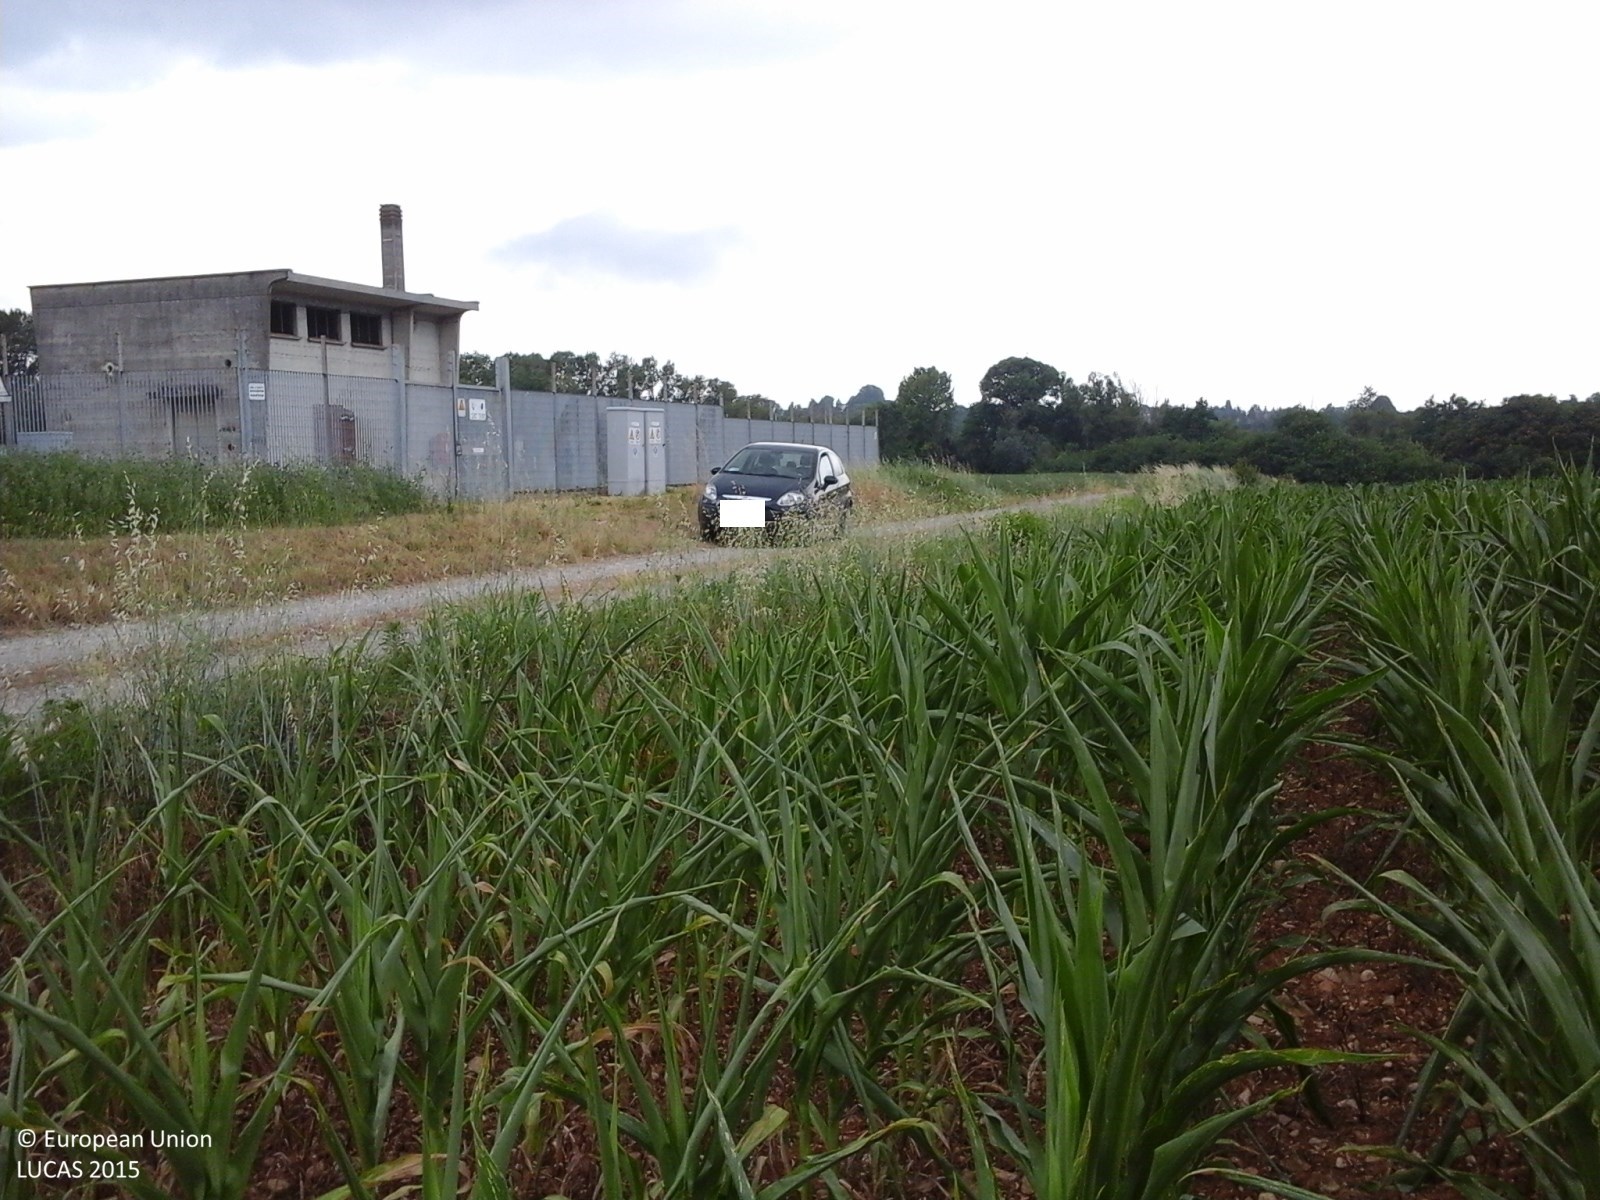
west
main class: Cropland
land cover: Maize
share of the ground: > 75 %
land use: Agriculture (excluding fallow land and kitchen gardens)
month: June
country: IT
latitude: 44.8734
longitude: 9.8863
